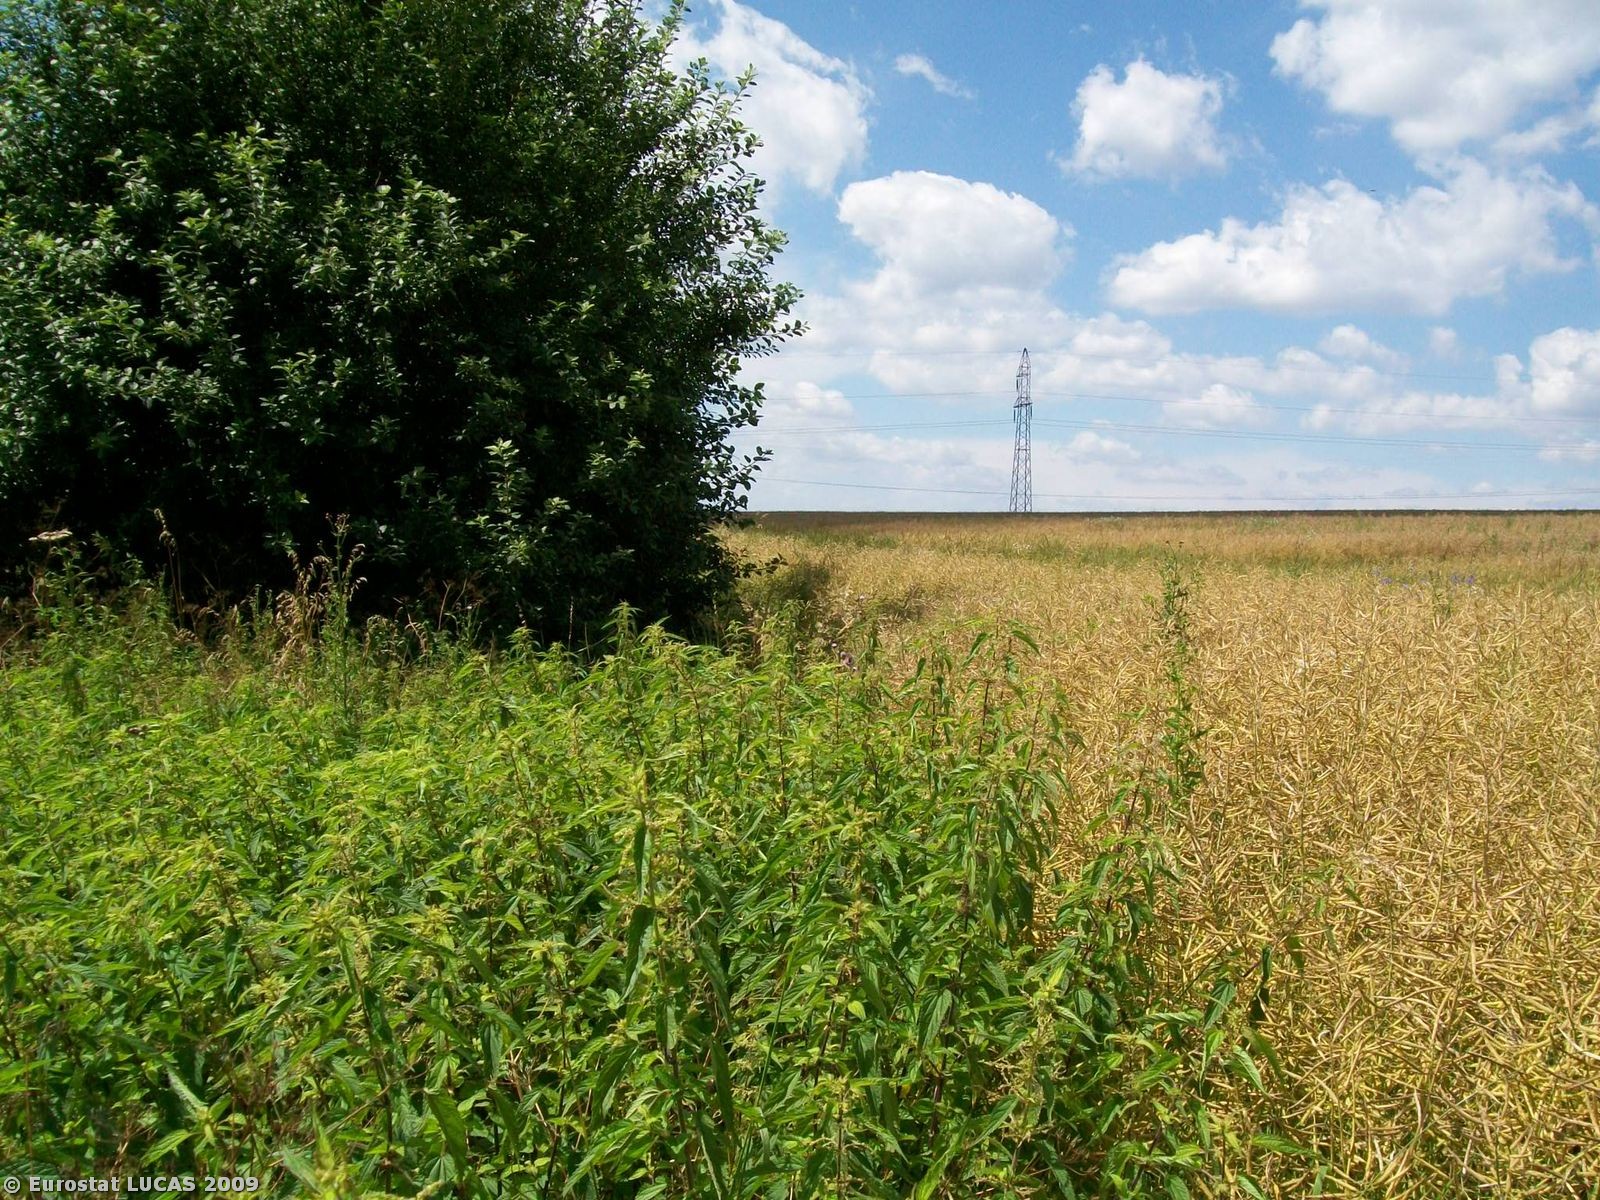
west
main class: Cropland
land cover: Rape and turnip rape
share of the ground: > 75 %
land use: Agriculture (excluding fallow land and kitchen gardens)
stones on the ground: < 10 %
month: July
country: PL
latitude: 51.1137
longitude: 15.1315
